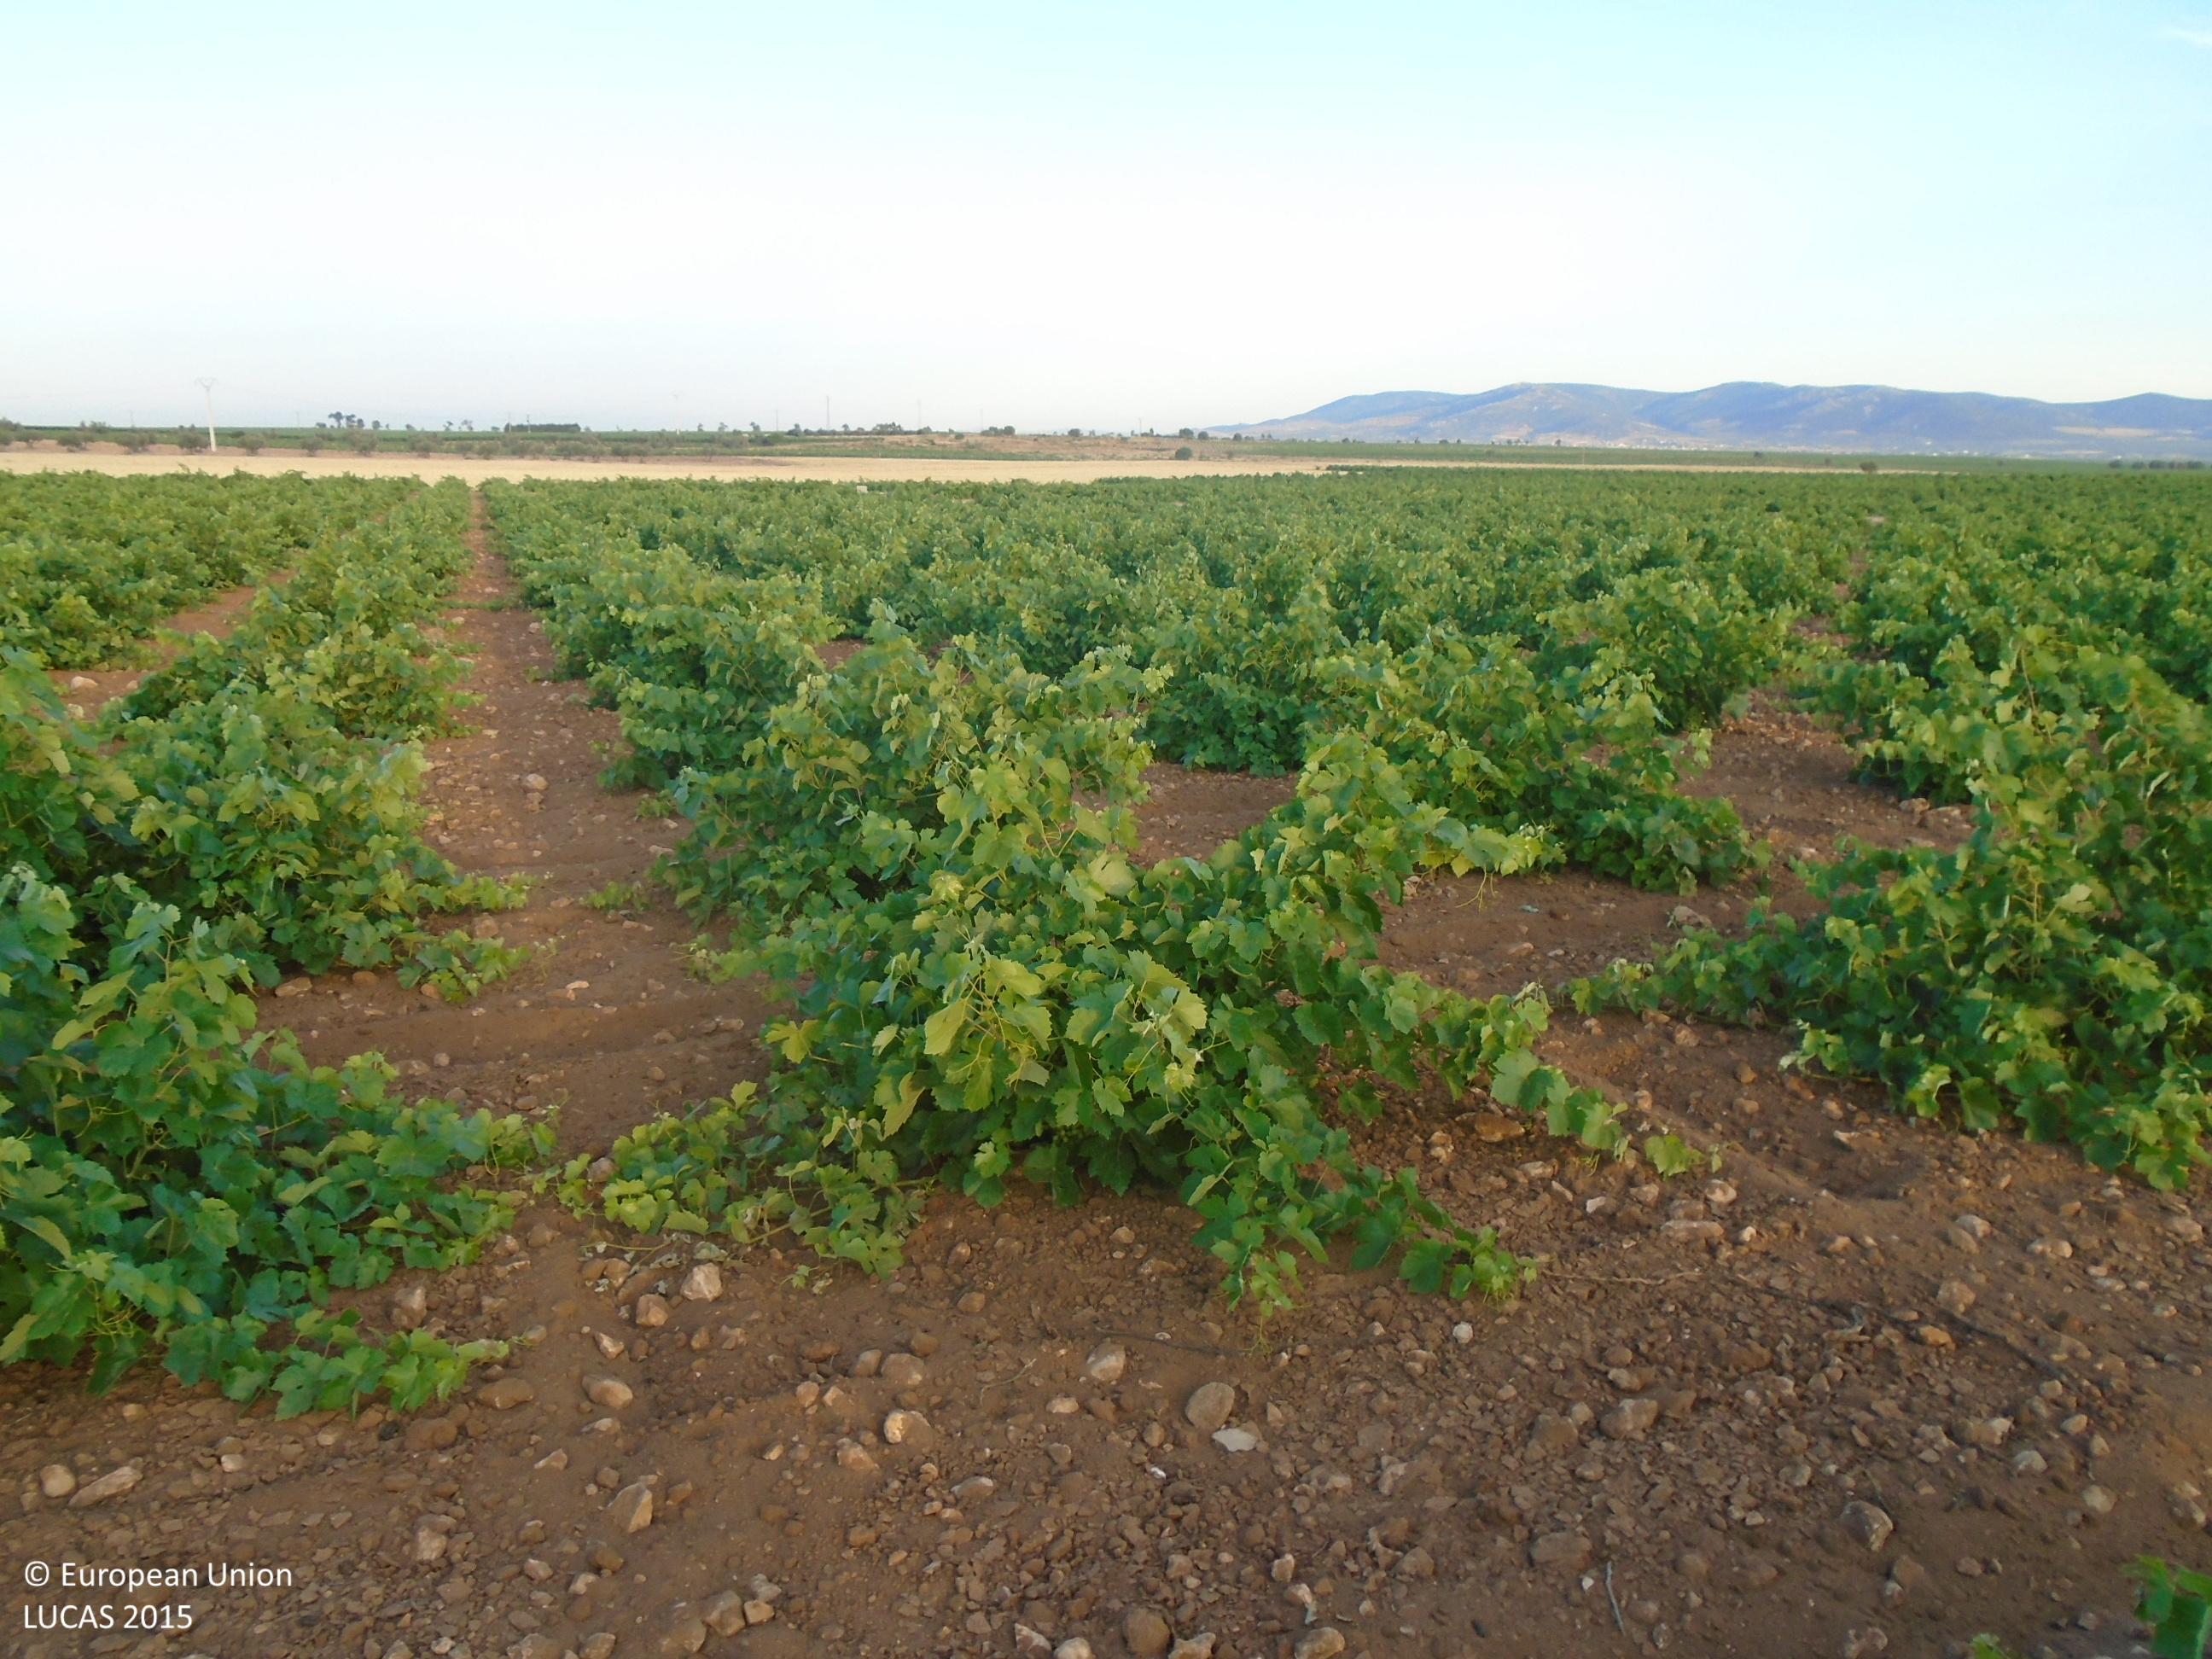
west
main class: Cropland
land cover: Vineyards
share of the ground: 50 - 75 %
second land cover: Other bare soil
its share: > 75 %
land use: Agriculture (excluding fallow land and kitchen gardens)
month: June
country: ES
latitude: 39.2001
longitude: -3.5085
